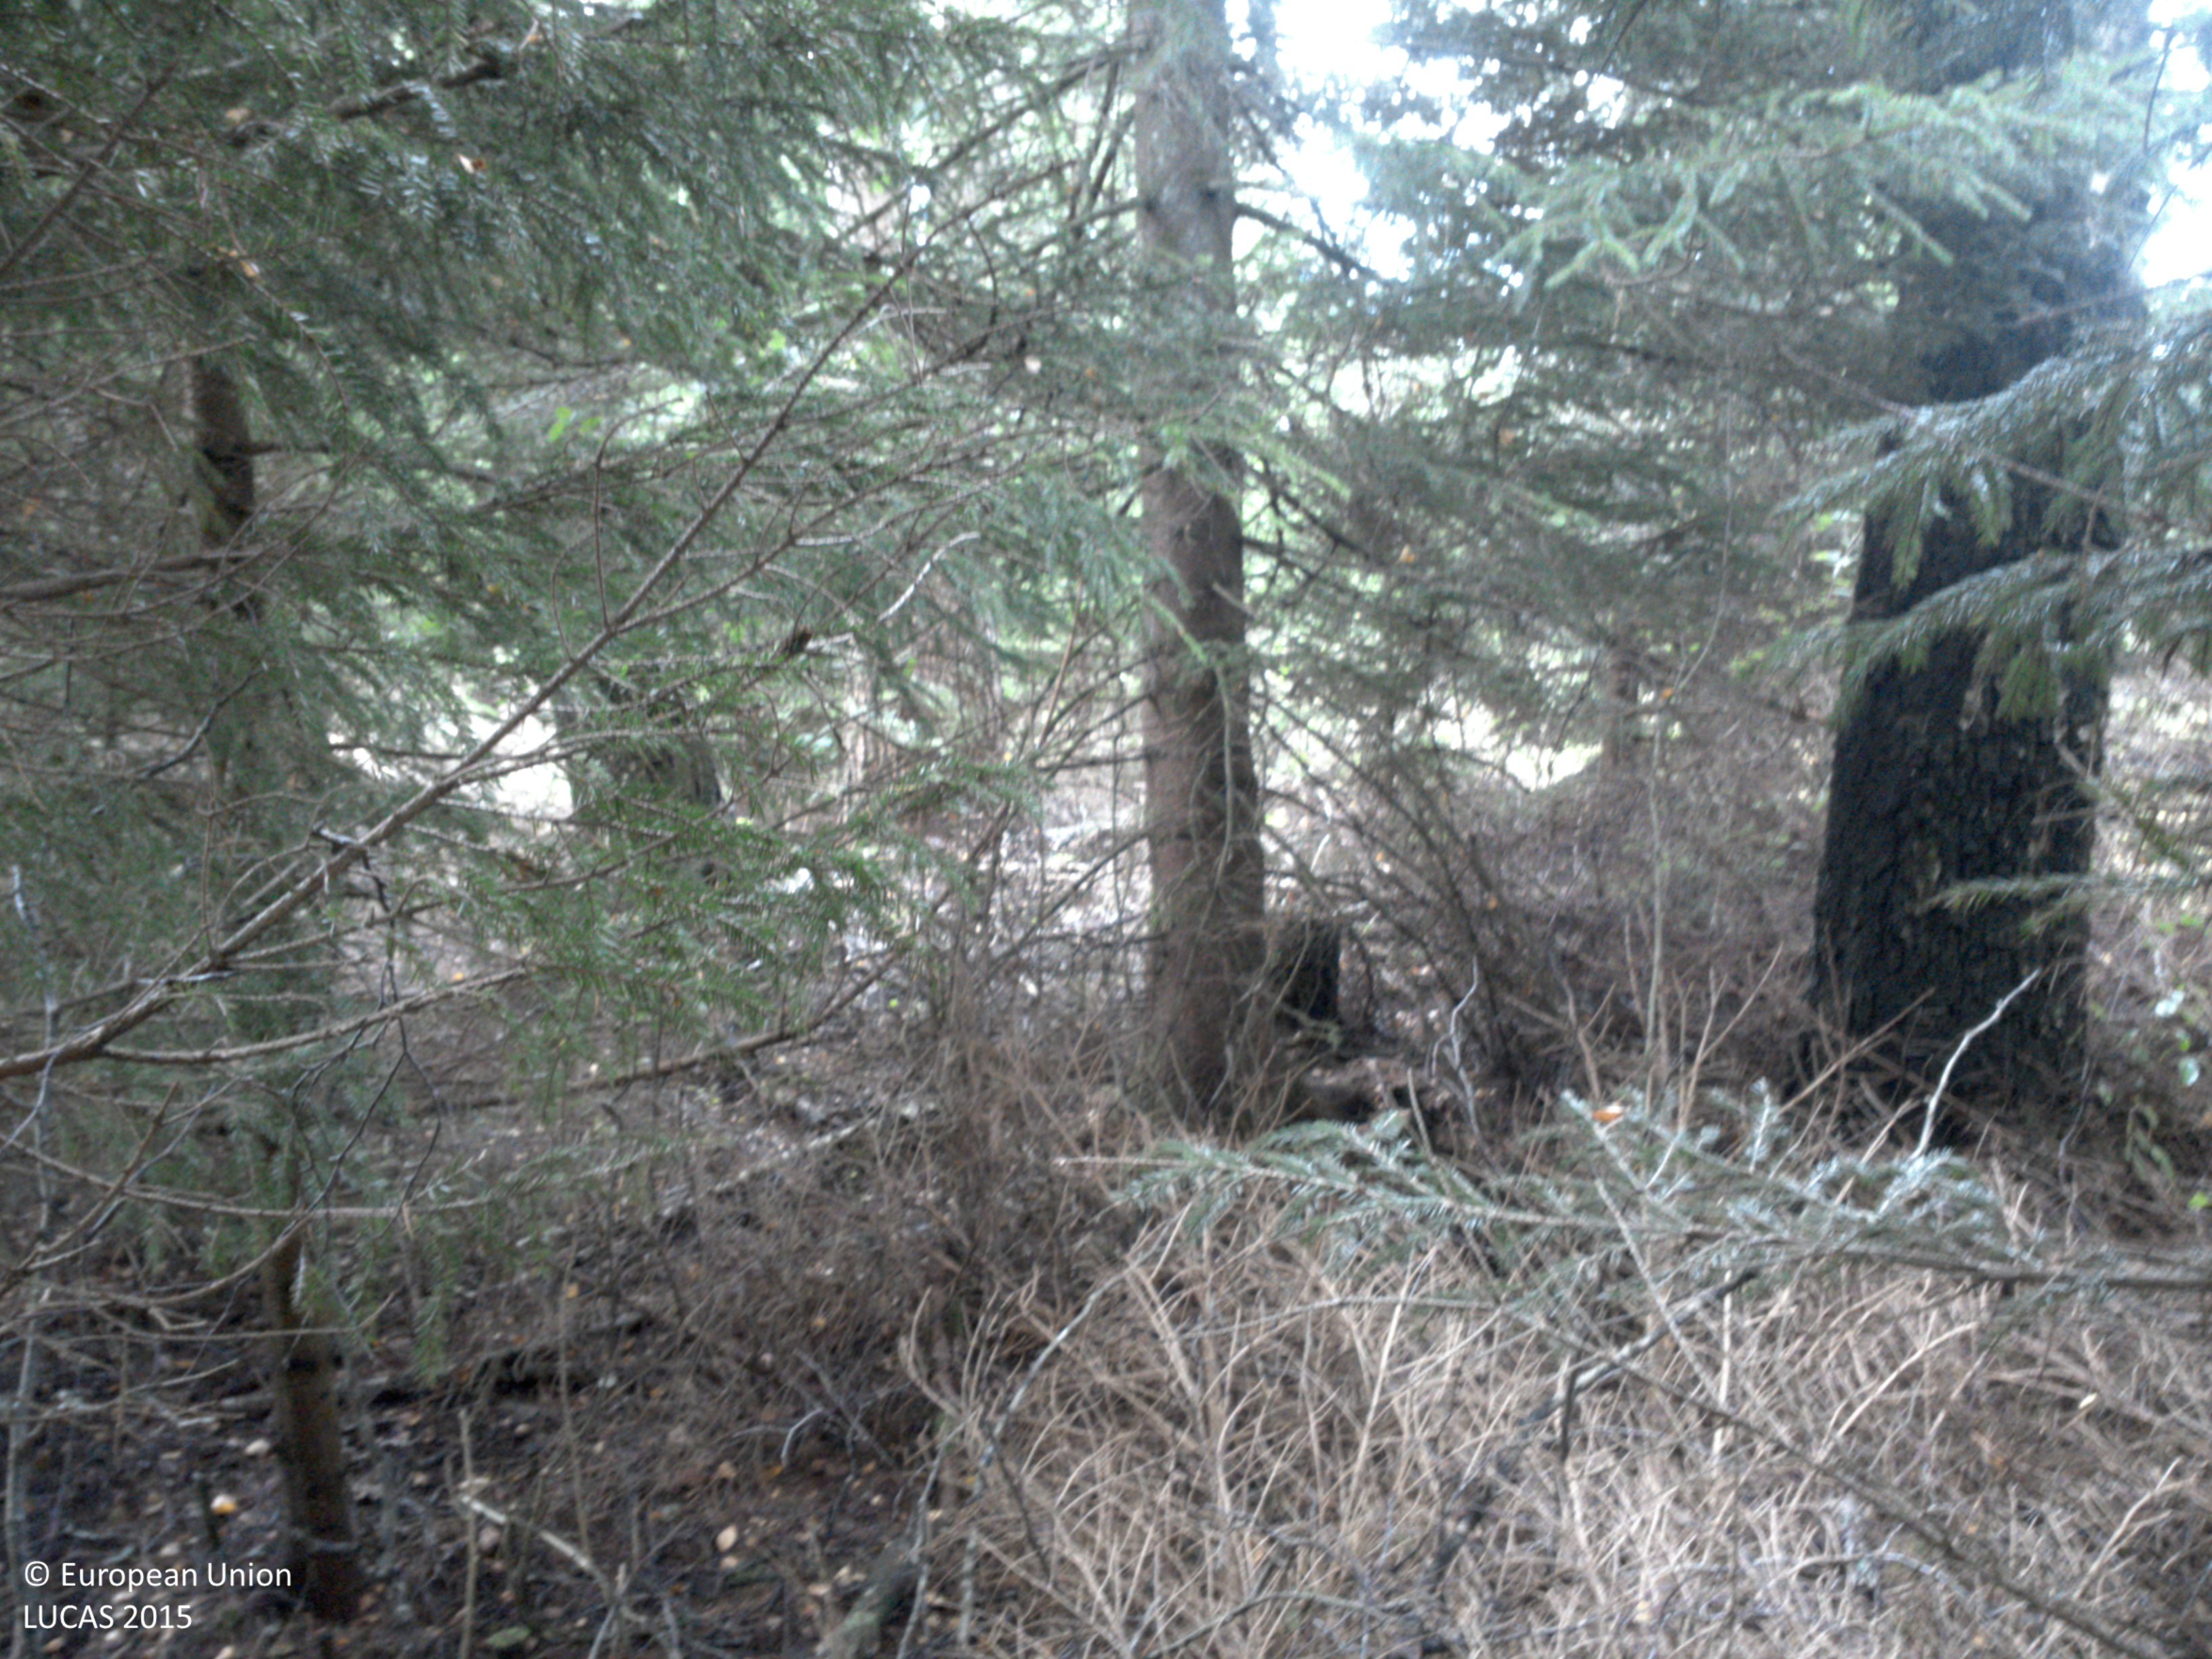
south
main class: Woodland
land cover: Spruce dominated coniferous woodland
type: boreal forest
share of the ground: > 75 %
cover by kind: coniferous forest trees 75 %, lichens and mosses 25 %
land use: Forestry
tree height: > 5 m
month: August
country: SE
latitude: 58.3263
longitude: 12.2666
